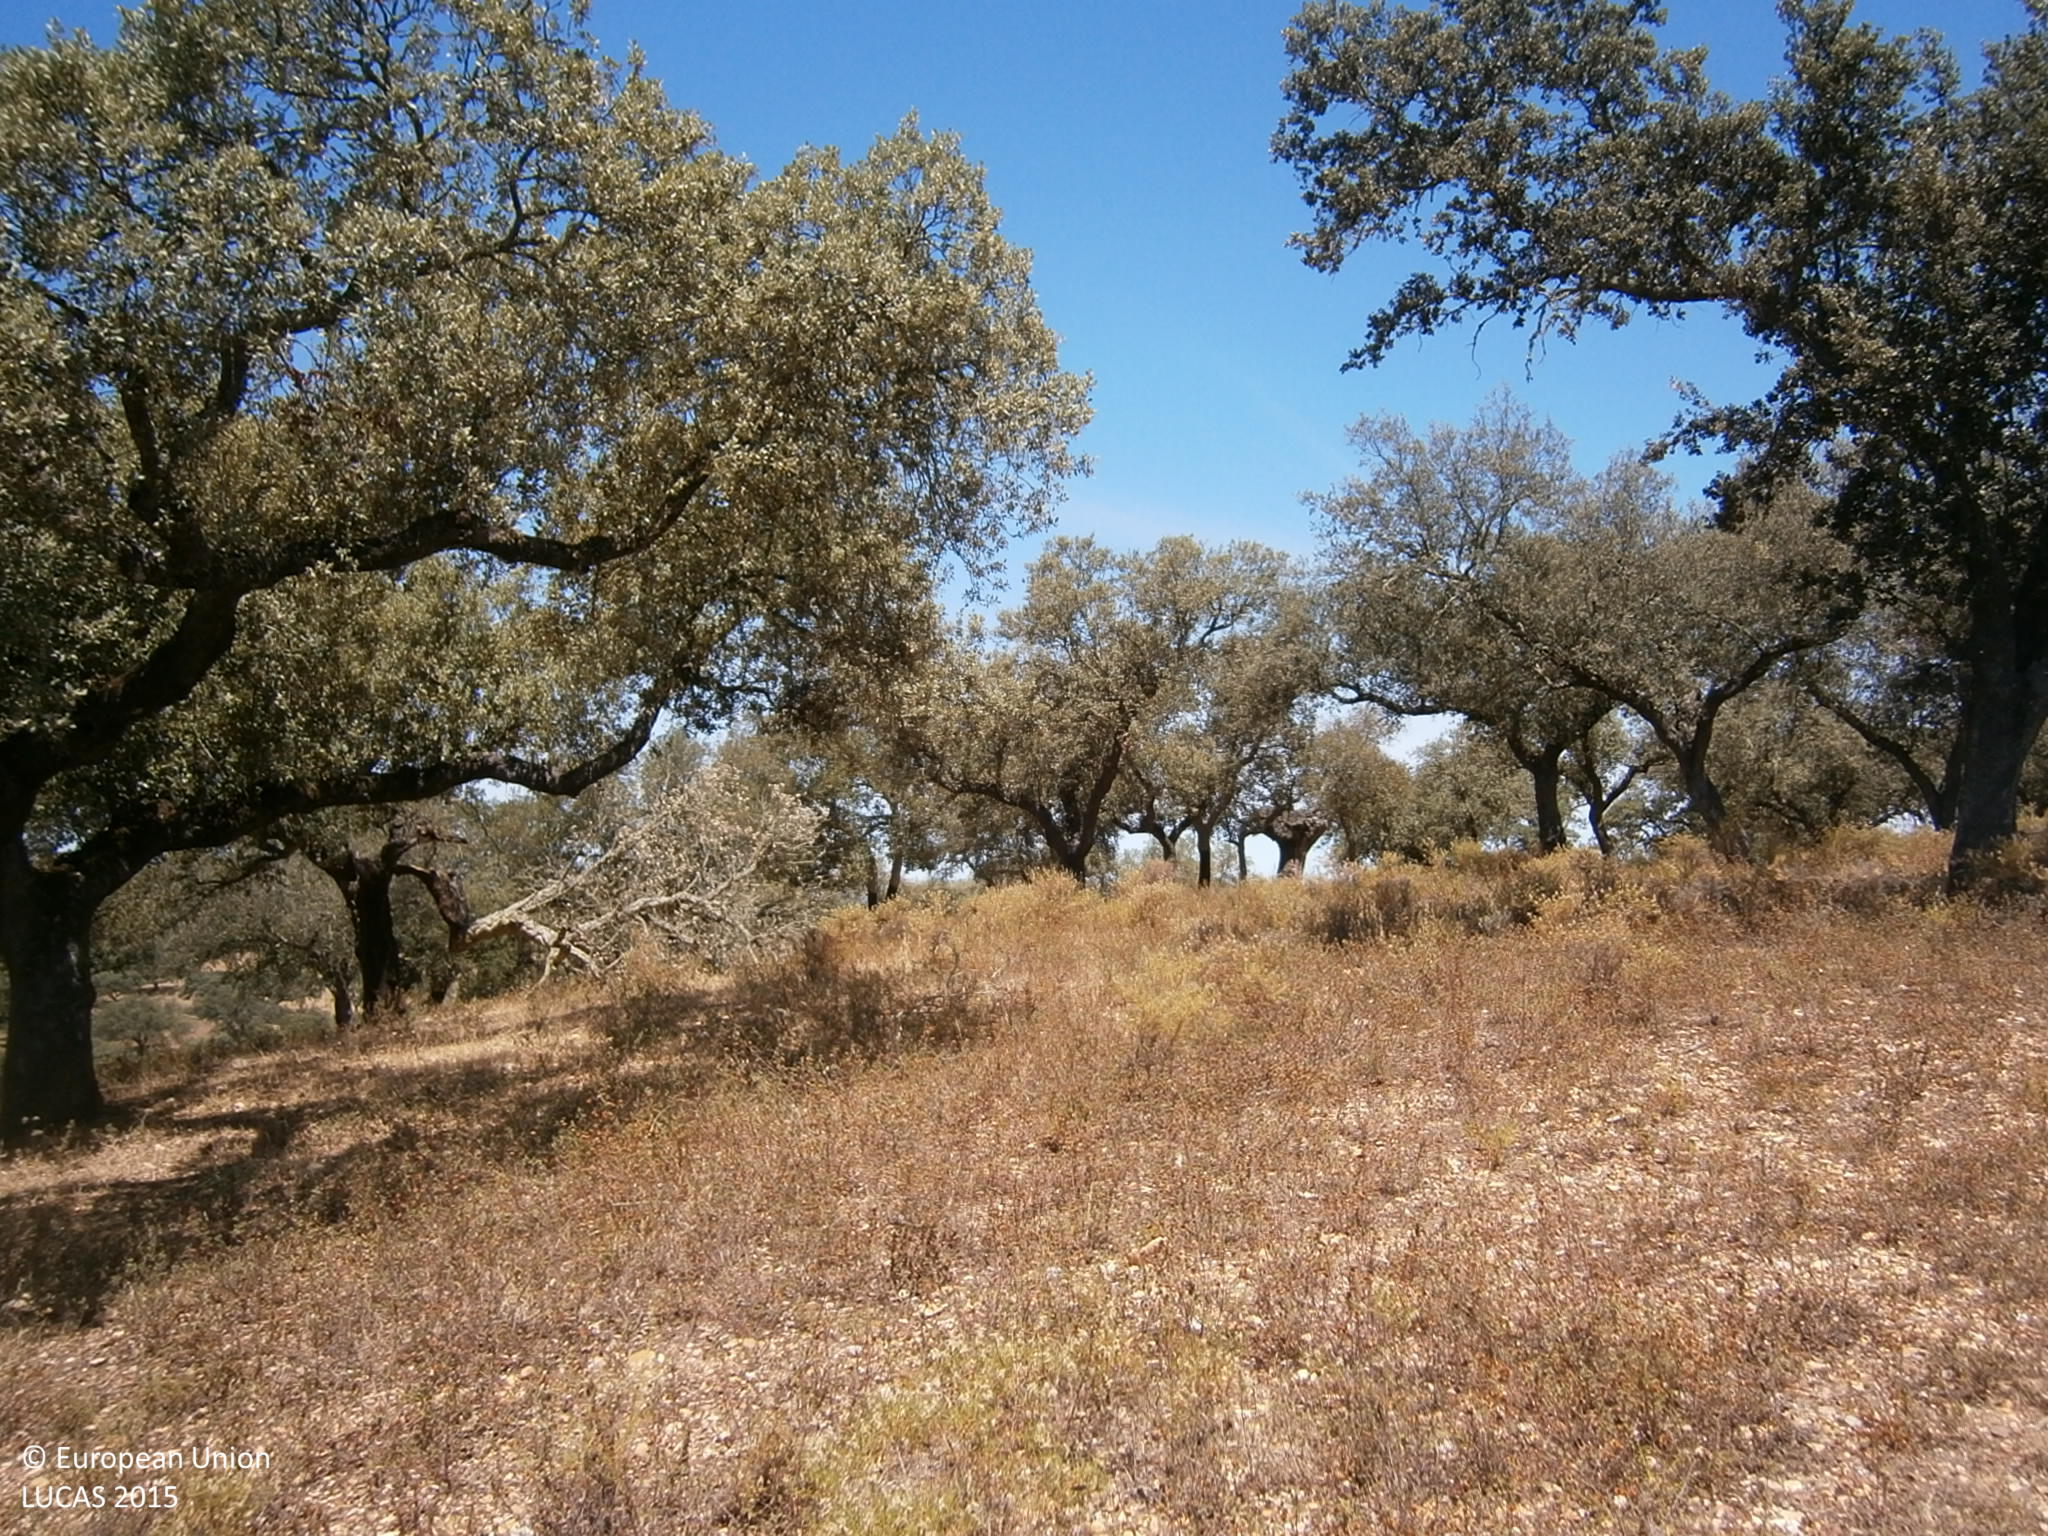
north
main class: Woodland
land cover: Broadleaved woodland
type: broadleaved evergreen forest
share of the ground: 25 - 50 %
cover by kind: shrubs 55 %, broadleaved forest trees 45 %
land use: Forestry
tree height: > 5 m
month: July
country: ES
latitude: 38.6348
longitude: -7.2456
